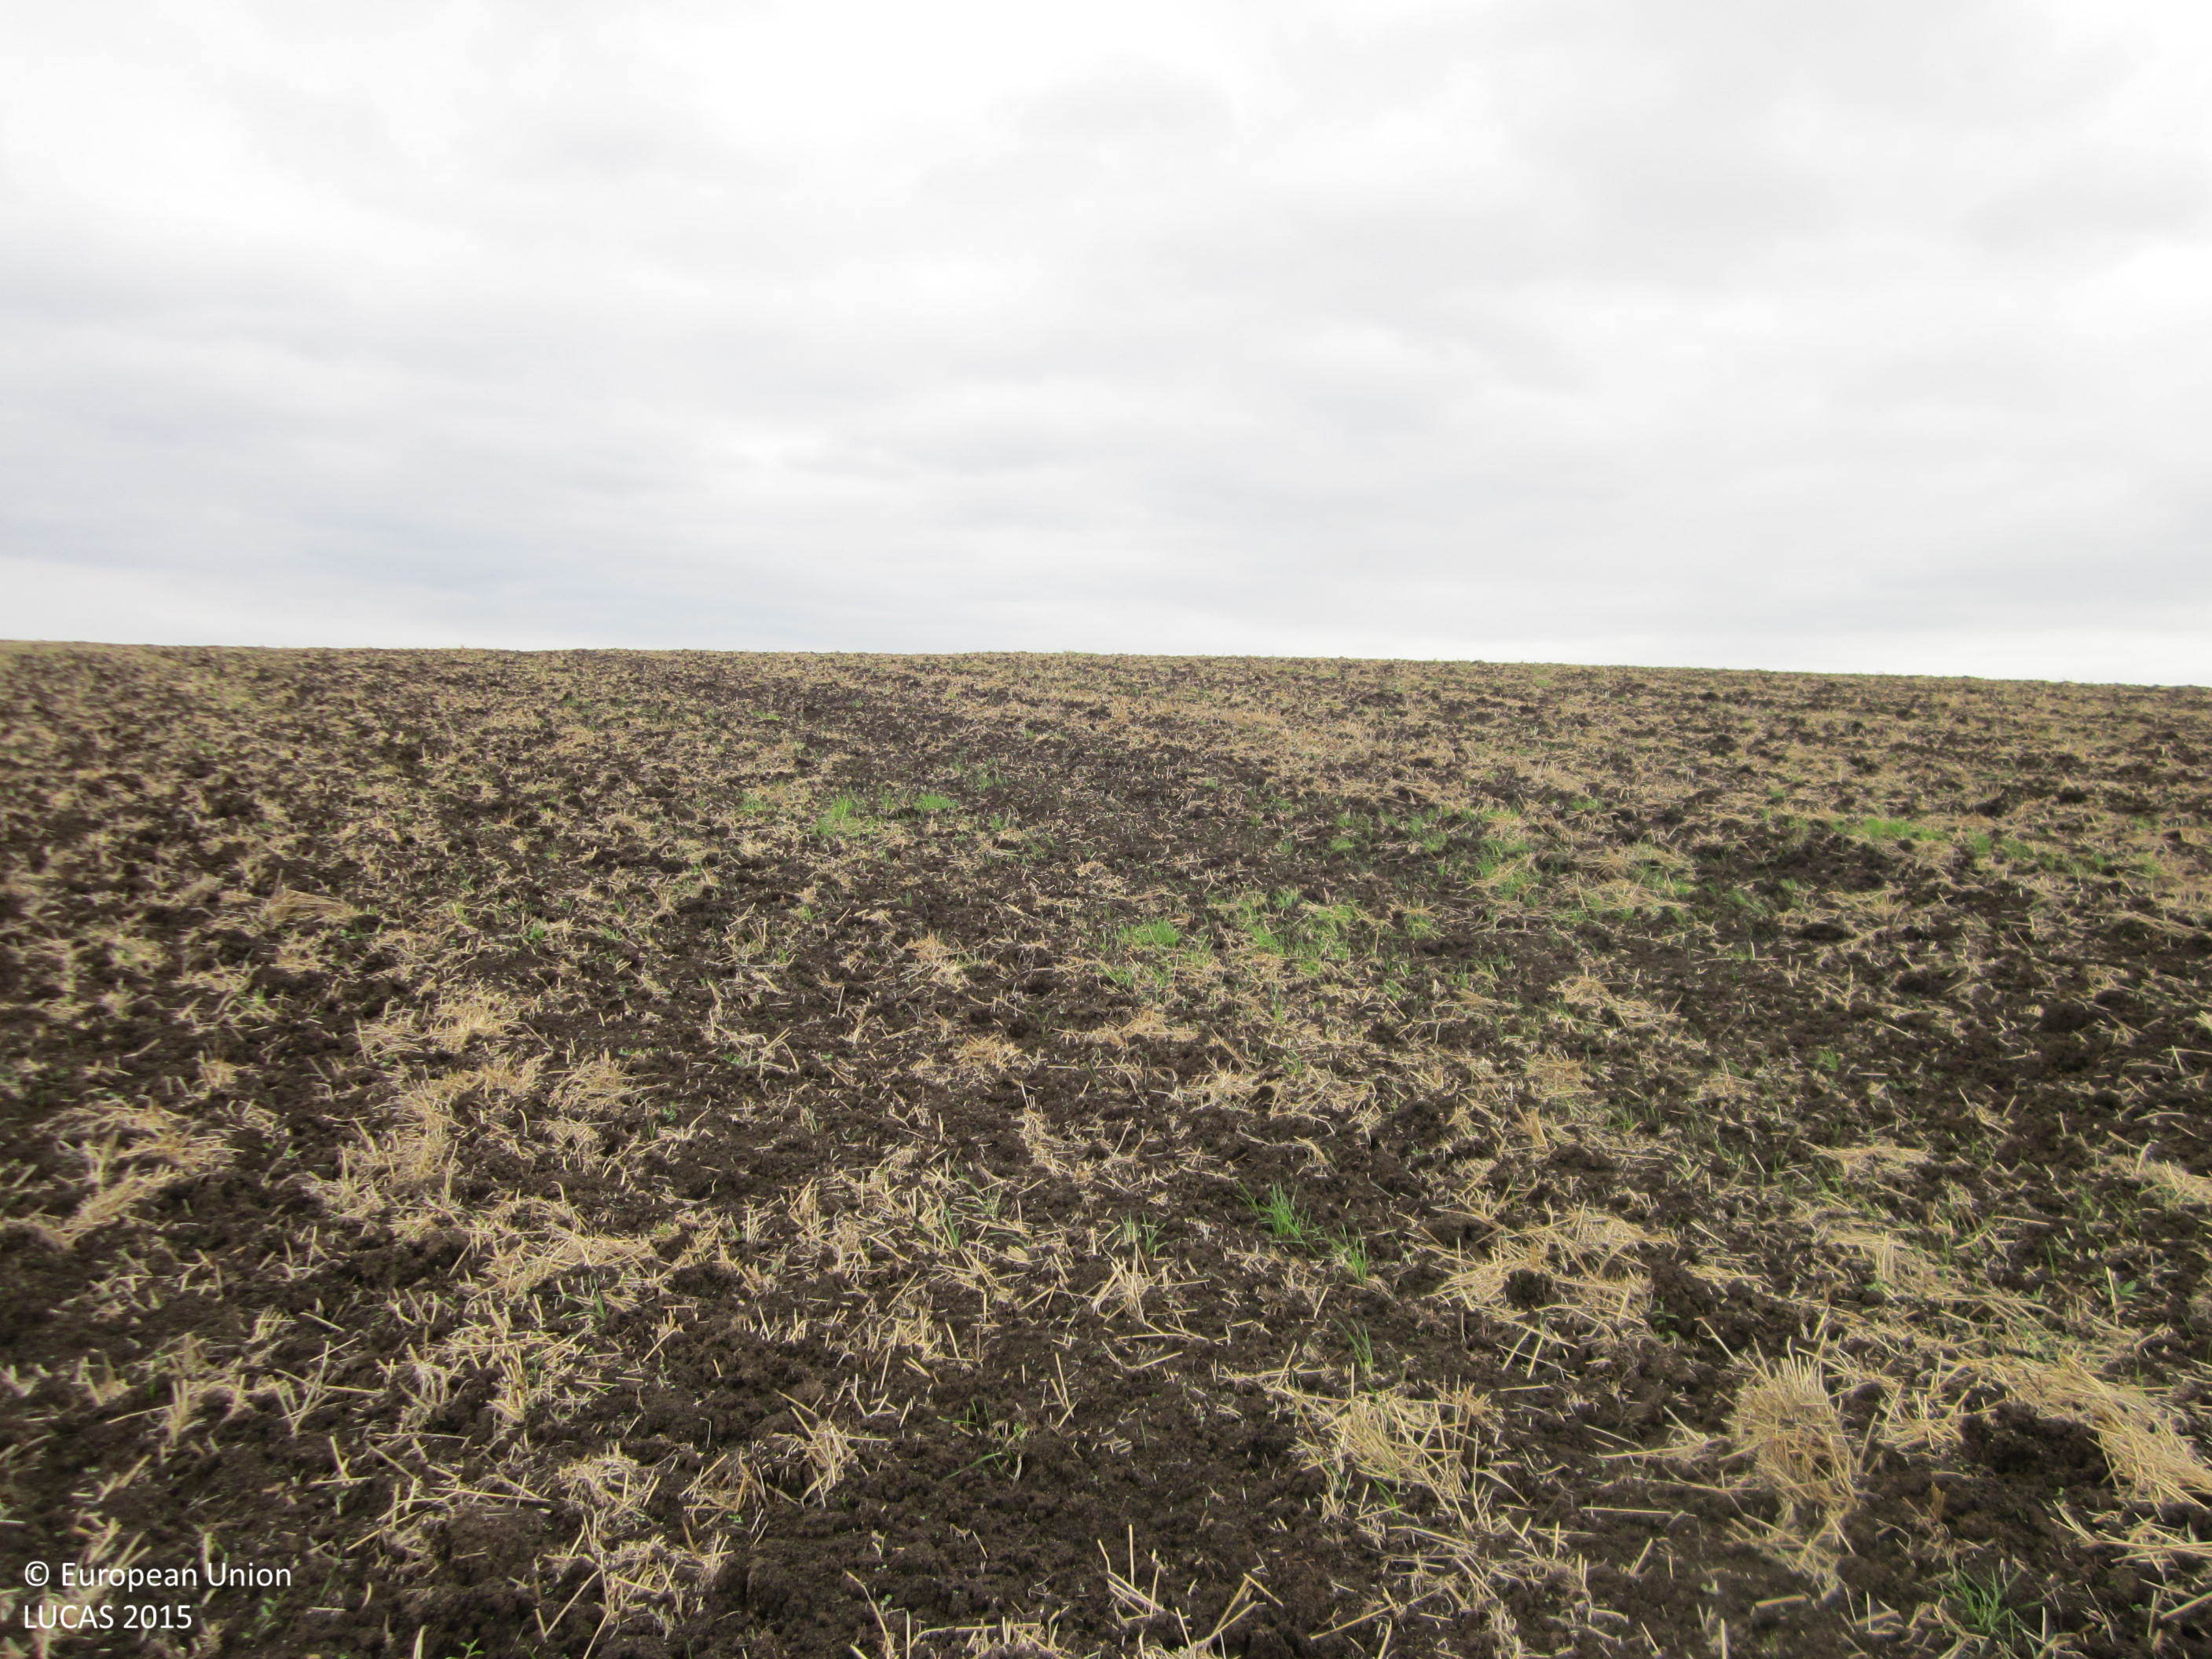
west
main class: Cropland
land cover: Common wheat
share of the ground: < 10 %
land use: Agriculture (excluding fallow land and kitchen gardens)
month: October
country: BG
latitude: 42.3739
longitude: 26.9455
